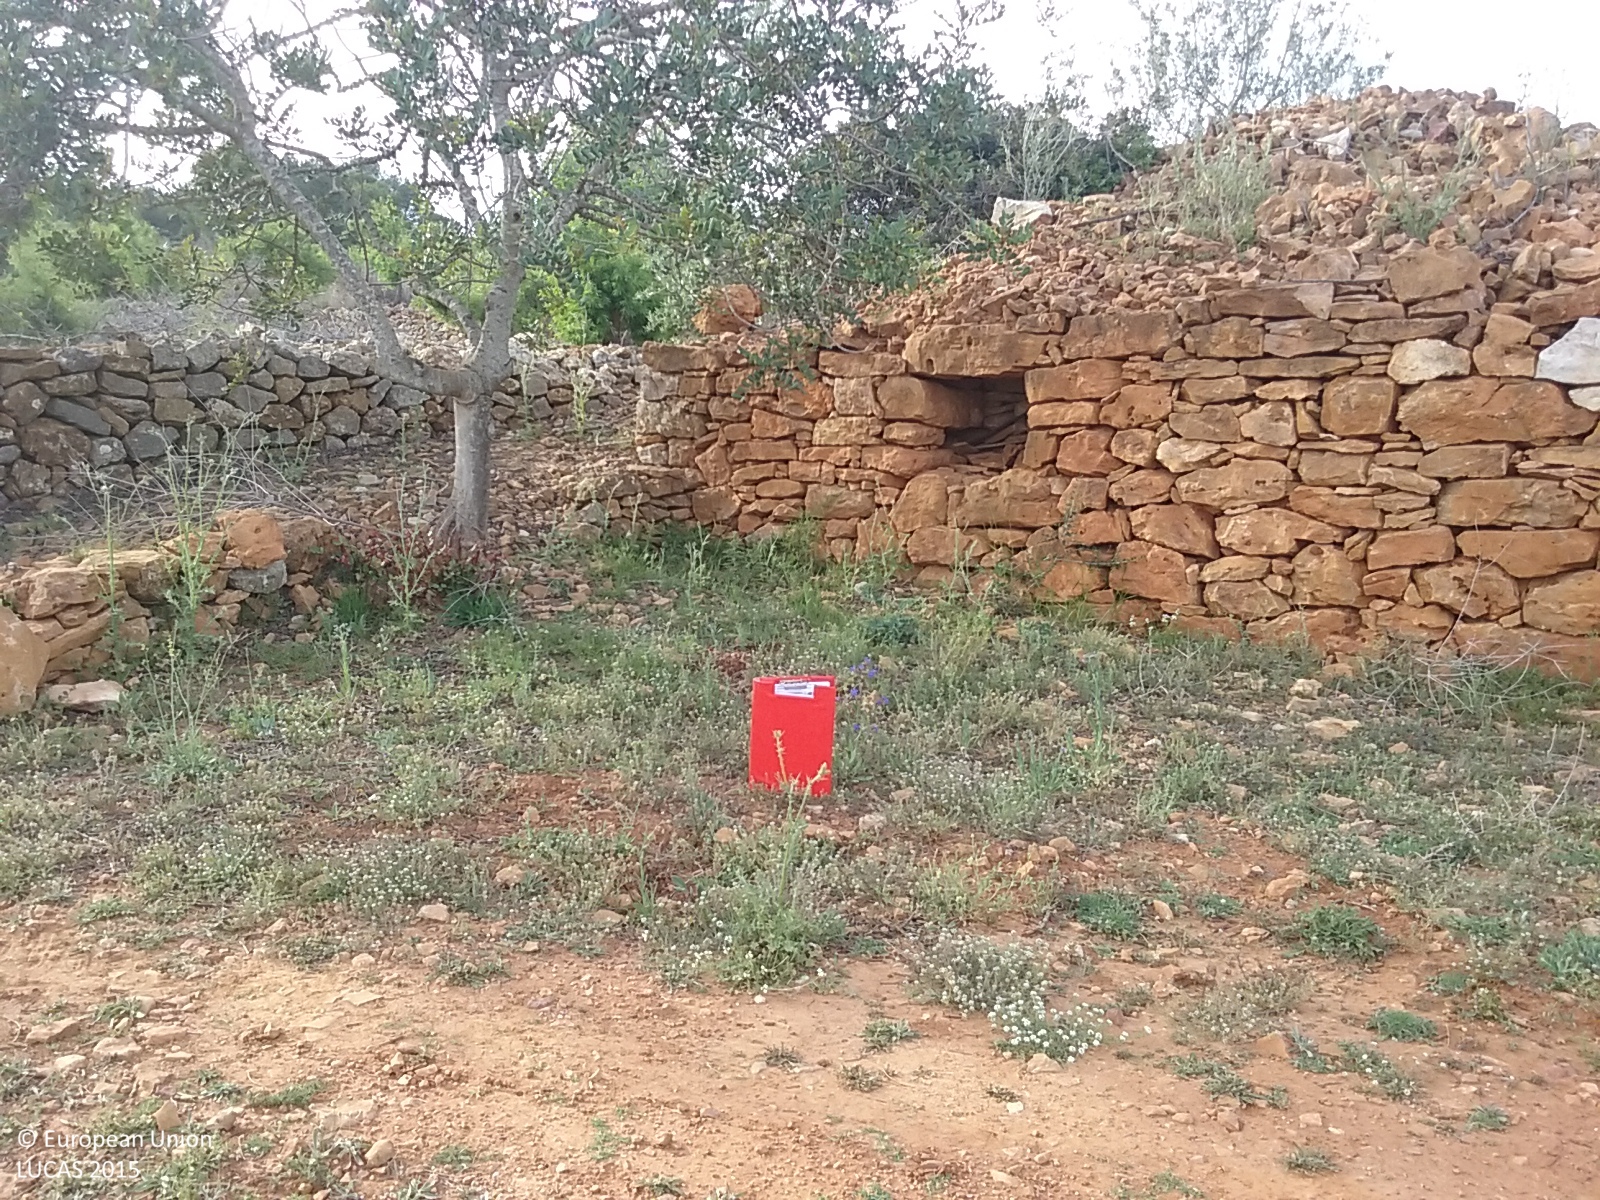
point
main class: Cropland
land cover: Olive groves
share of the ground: 25 - 50 %
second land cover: Grassland without tree/shrub cover
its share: 50 - 75 %
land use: Agriculture (excluding fallow land and kitchen gardens)
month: May
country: ES
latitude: 40.2175
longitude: 0.0680
